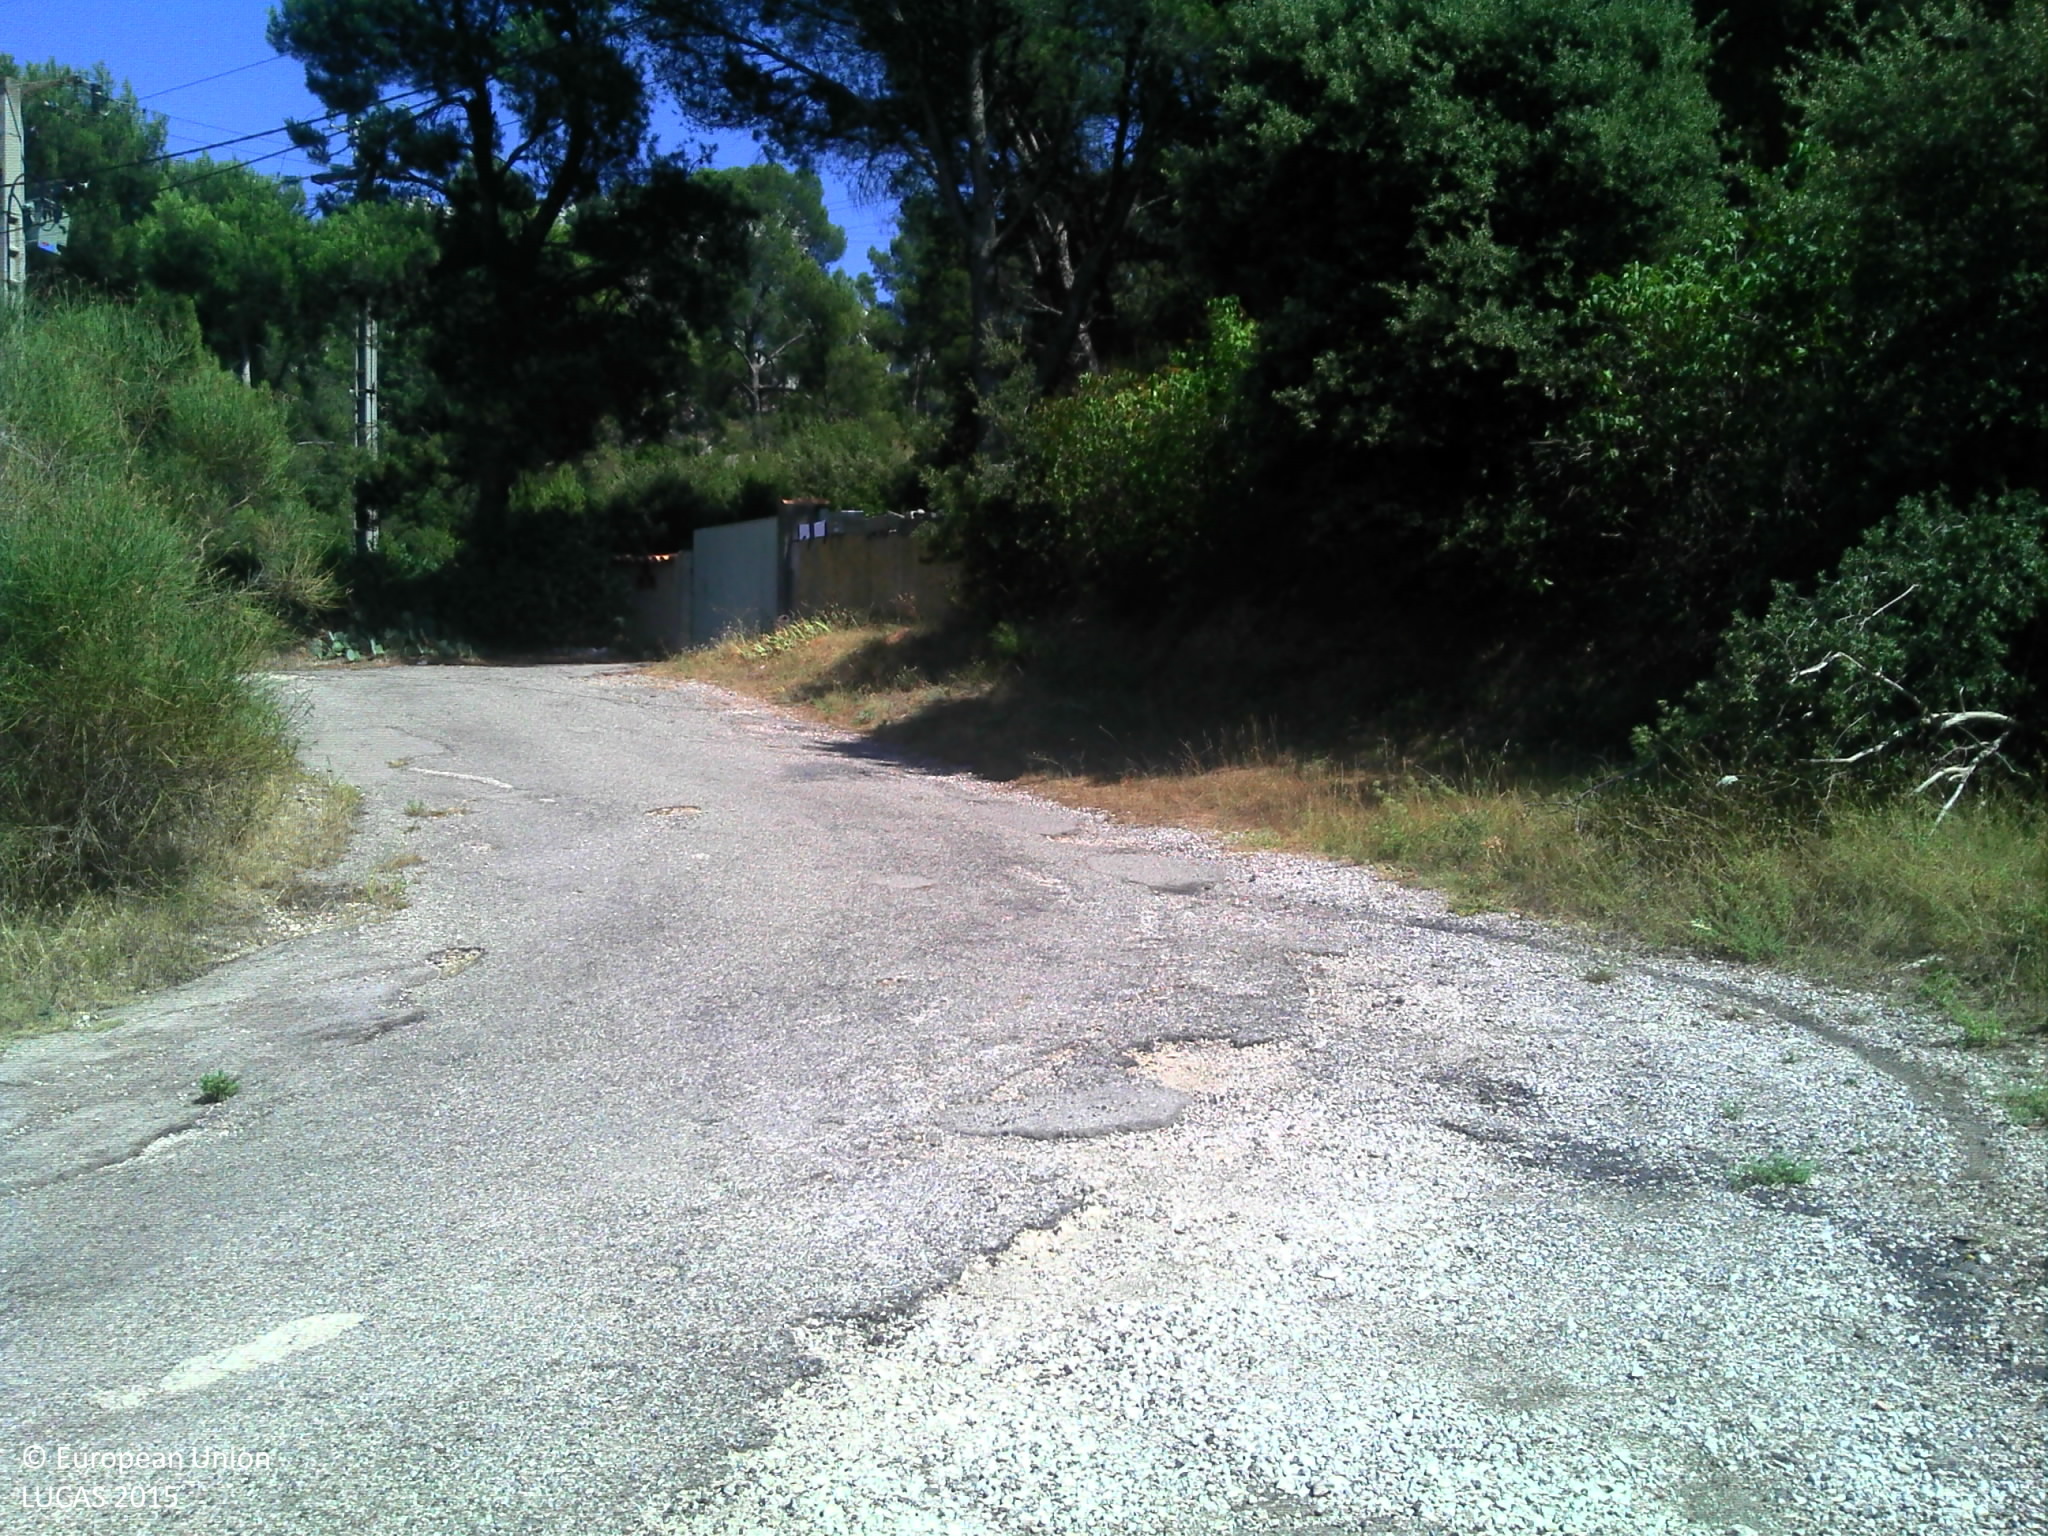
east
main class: Grassland
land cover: Grassland with sparse tree/shrub cover
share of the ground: > 75 %
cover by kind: herbaceous plants 85 %, coniferous forest trees 5 %, consolidated bare surface 5 %
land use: Residential
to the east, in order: Grassland with sparse tree/shrub cover; Artificial constructions in urban areas; Pine dominated mixed woodland; Electric lines; Pine dominated coniferous woodland; Rocks and stones; Pine dominated coniferous woodland; Shrubland without tree cover; Tracks; Rocks and stones; Shrubland without tree cover; Pine dominated coniferous woodland
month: August
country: FR
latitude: 43.3940
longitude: 5.2817
